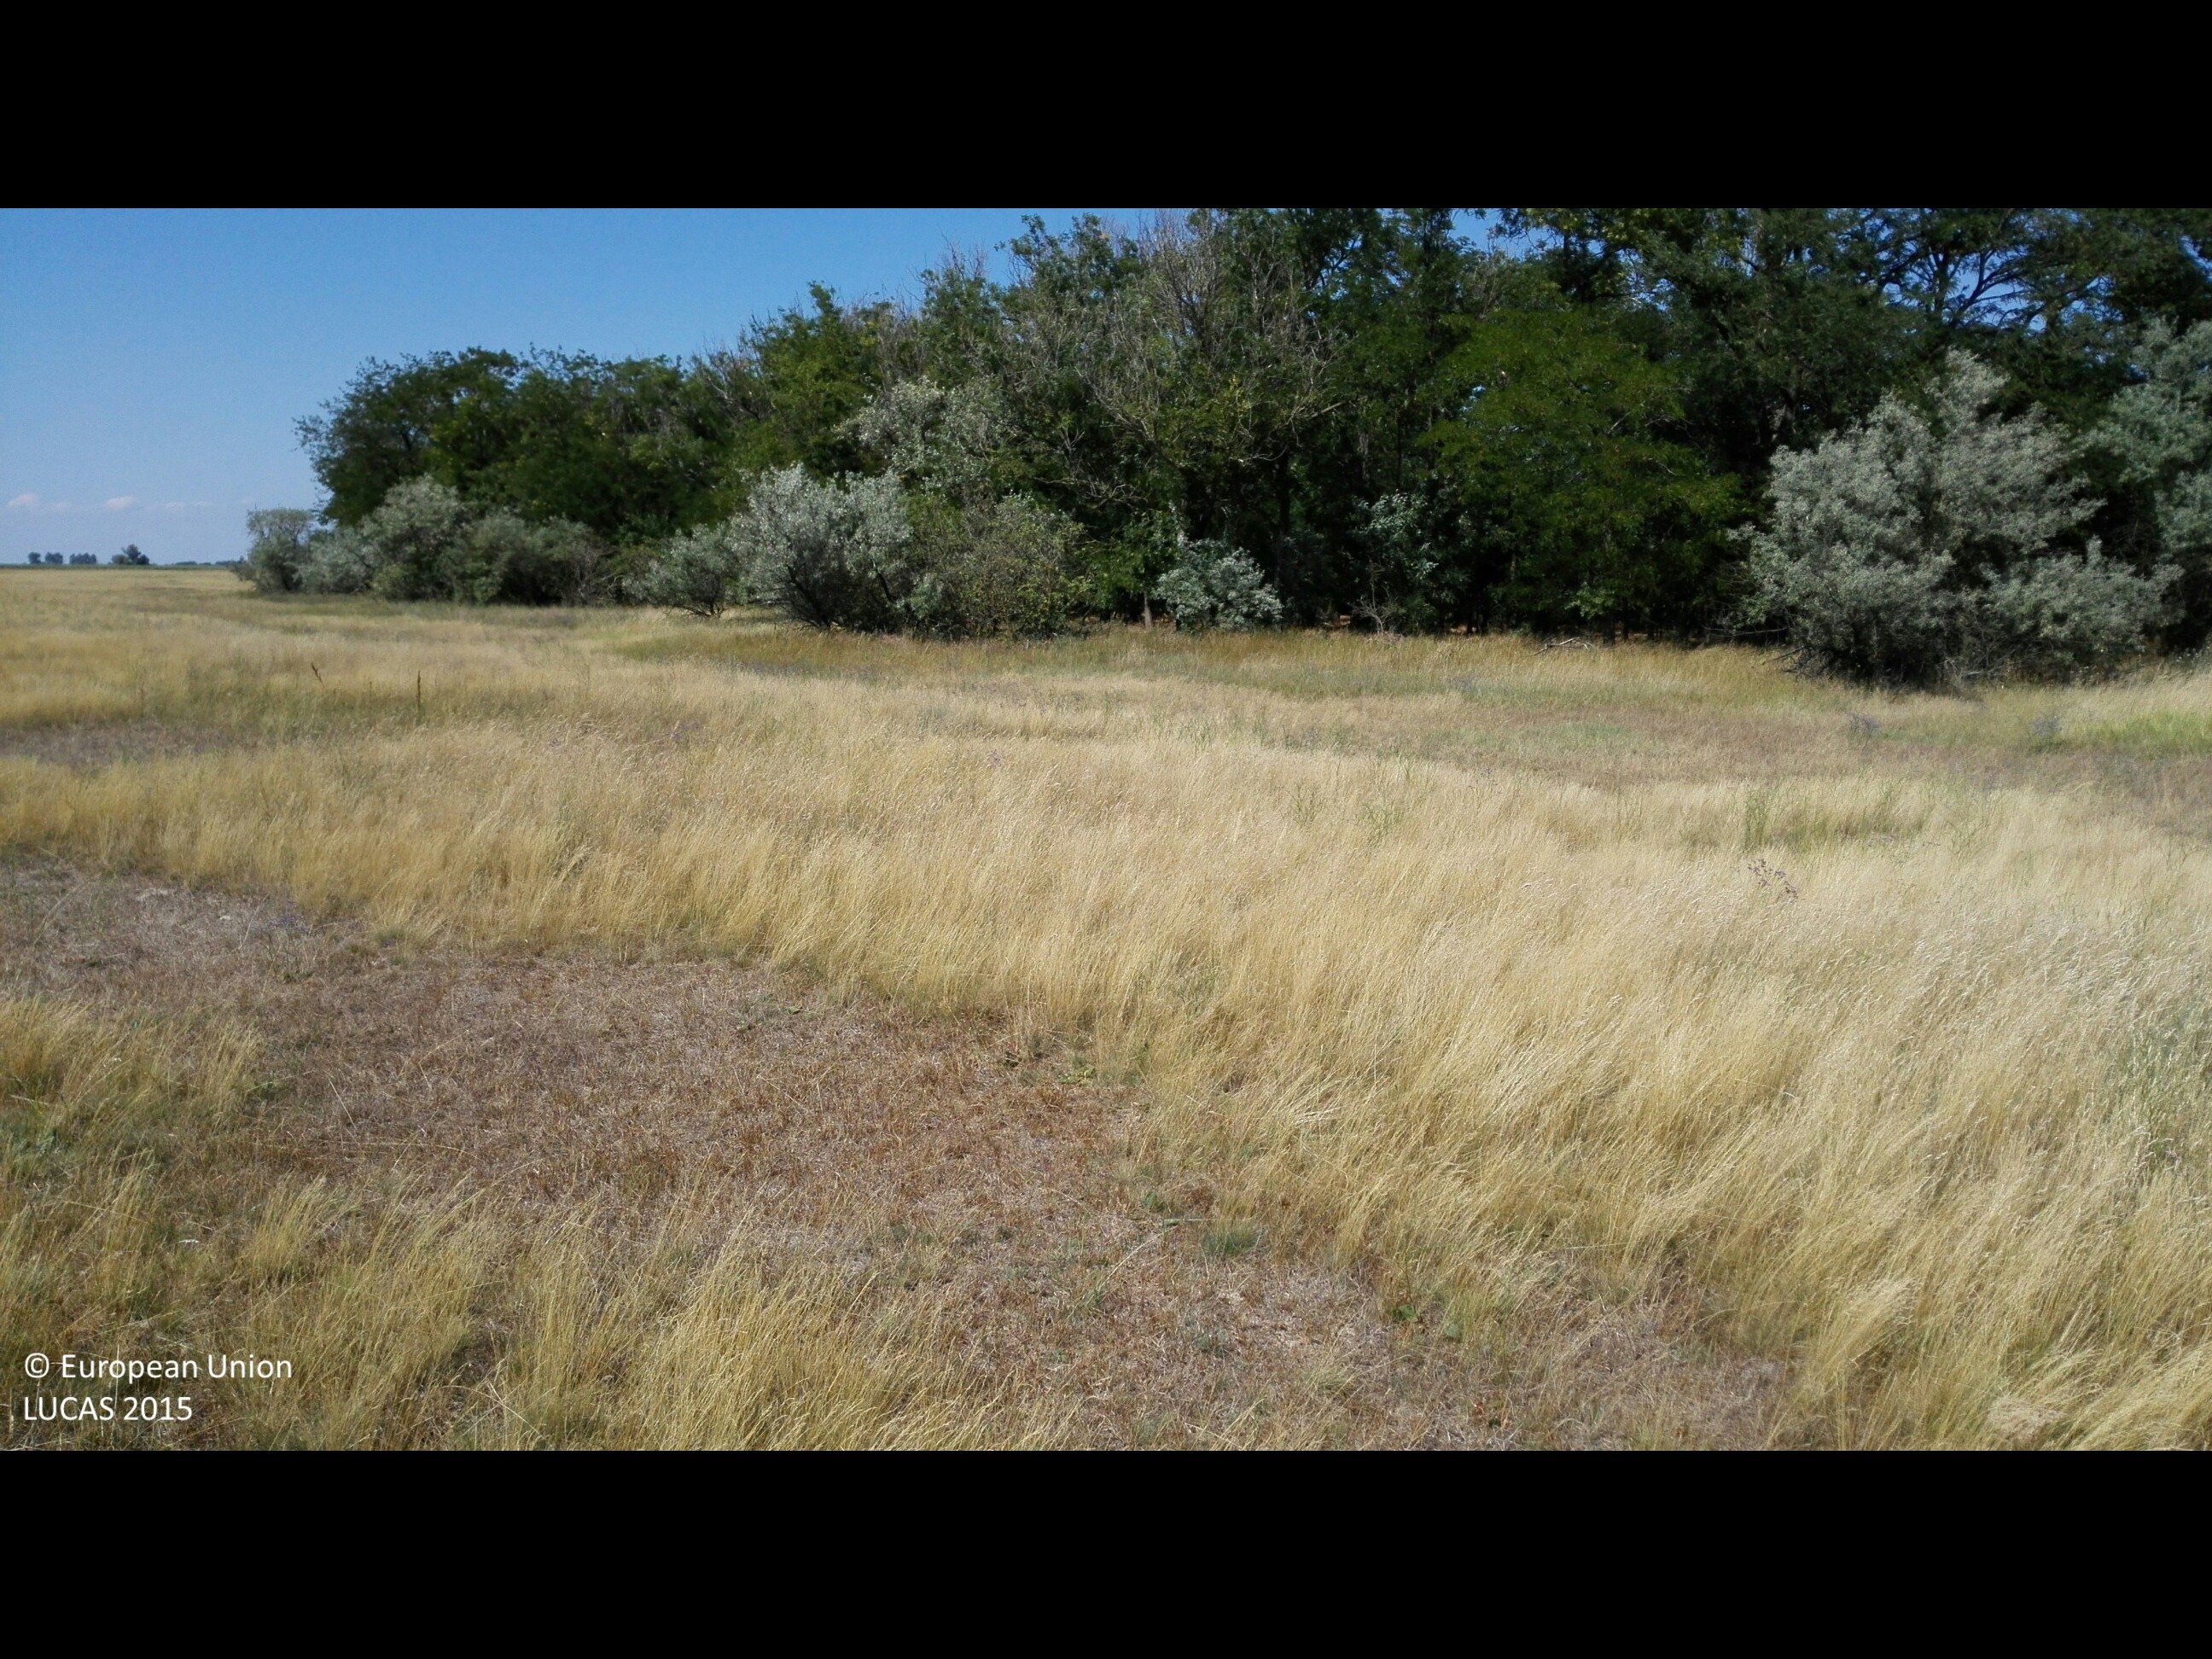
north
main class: Grassland
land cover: Grassland without tree/shrub cover
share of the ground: > 75 %
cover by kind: herbaceous plants 100 %
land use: Agriculture (excluding fallow land and kitchen gardens)
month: July
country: HU
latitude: 47.2605
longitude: 21.2852
